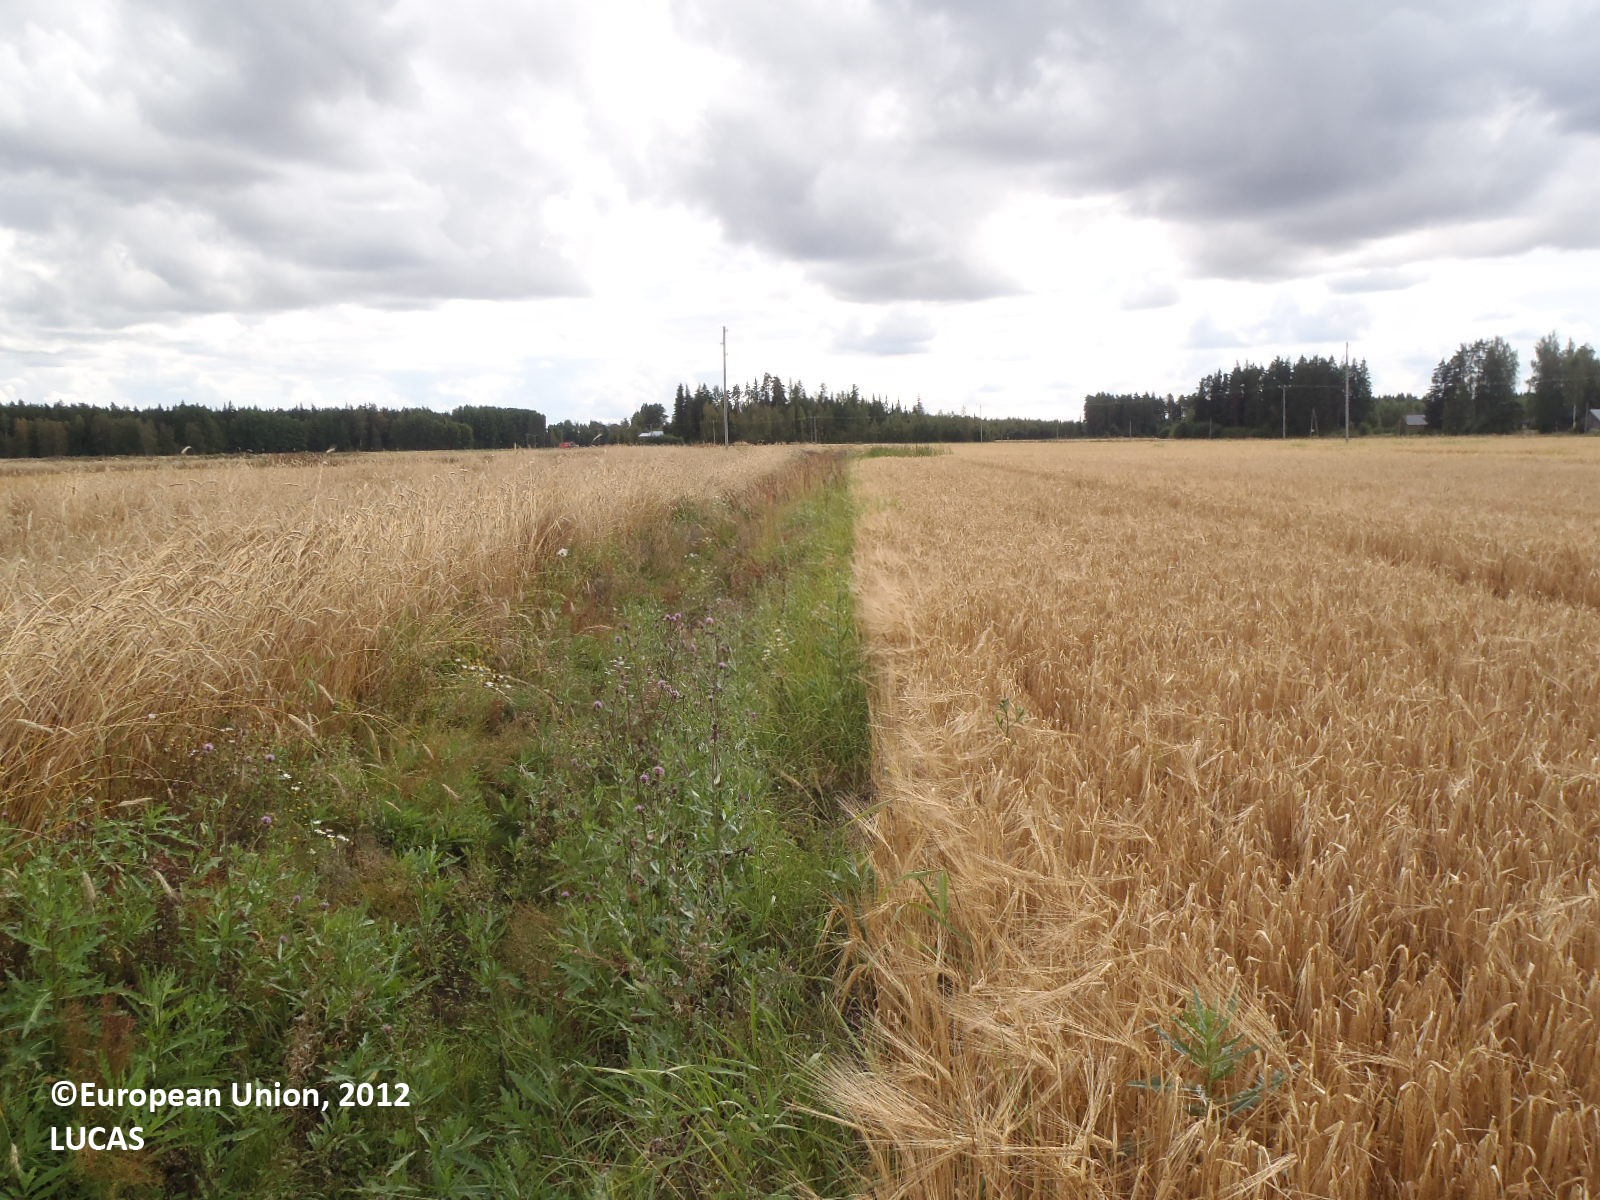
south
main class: Cropland
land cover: Barley
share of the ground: > 75 %
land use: Agriculture (excluding fallow land and kitchen gardens)
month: August
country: FI
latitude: 60.6844
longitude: 22.4641
